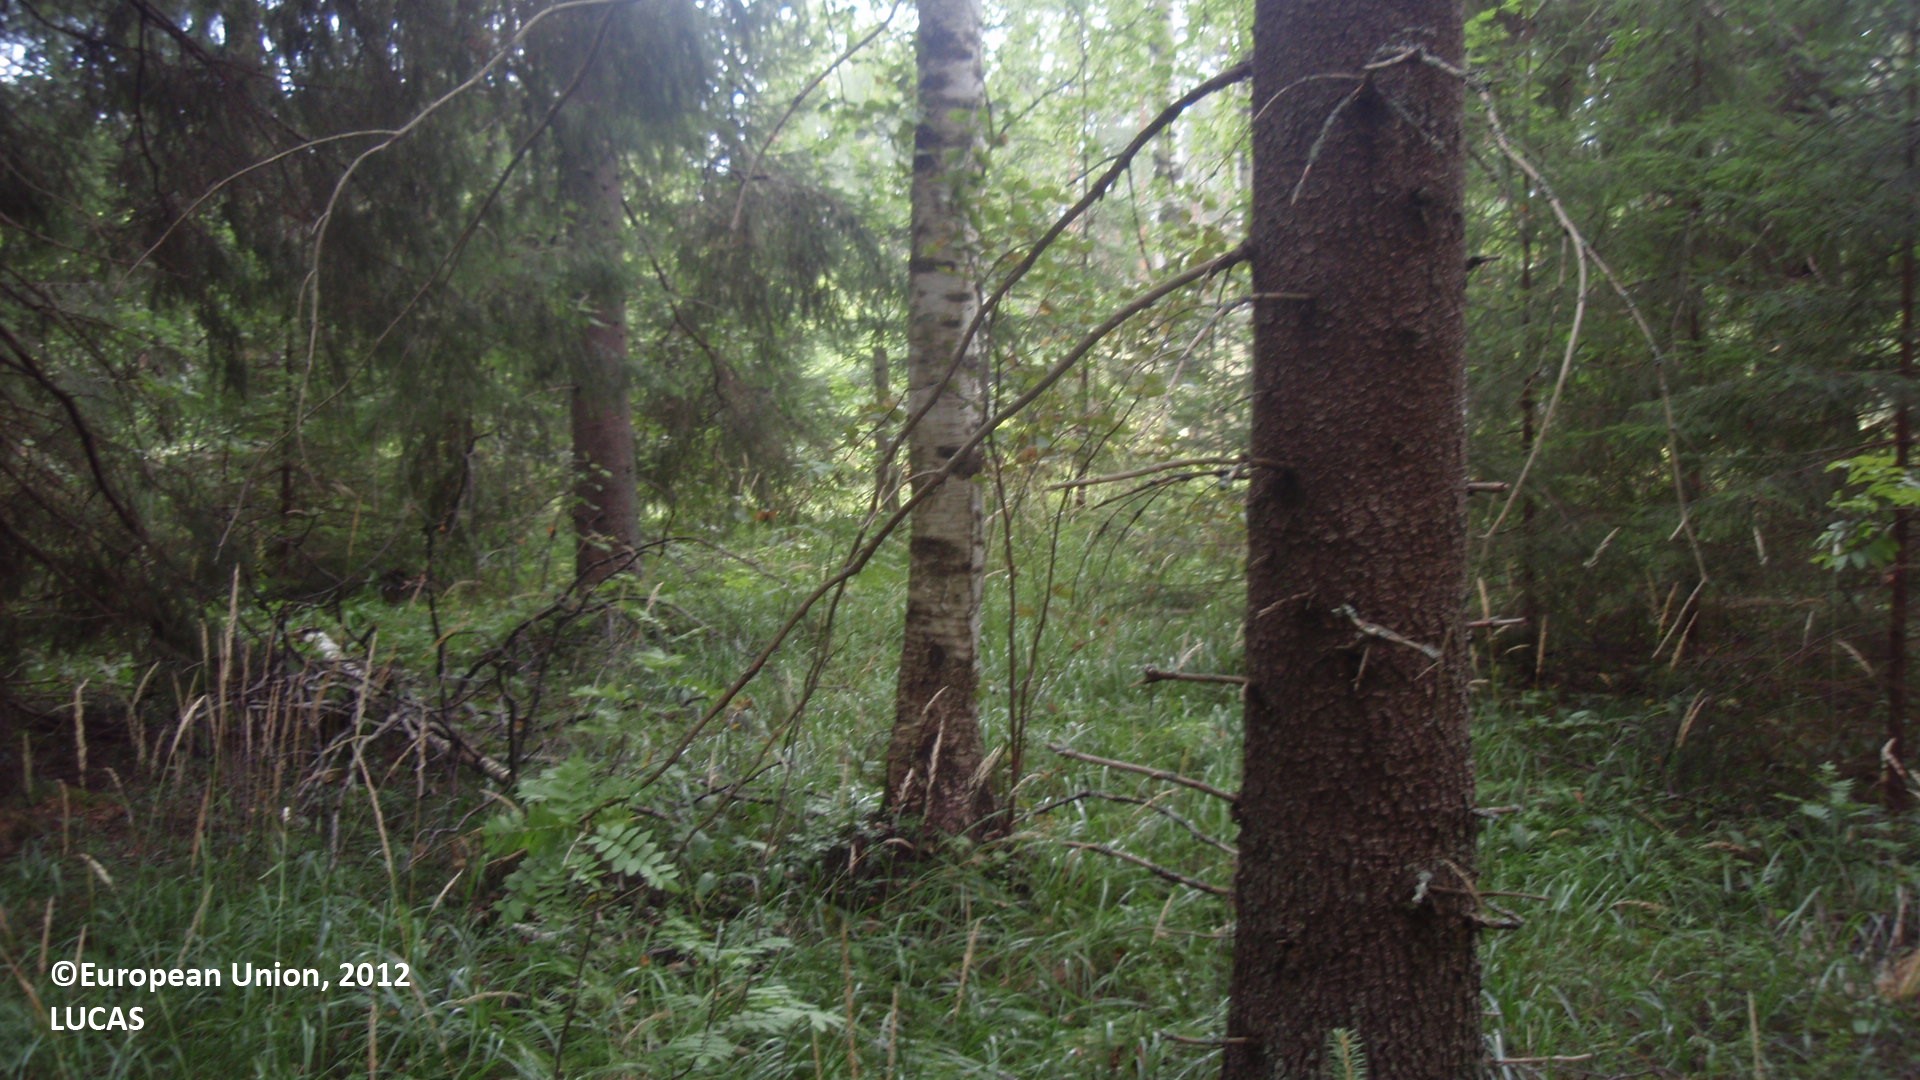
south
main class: Woodland
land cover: Spruce dominated mixed woodland
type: boreal forest
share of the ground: 50 - 75 %
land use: Forestry
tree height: > 5 m
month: August
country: FI
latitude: 60.8812
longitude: 27.2527
